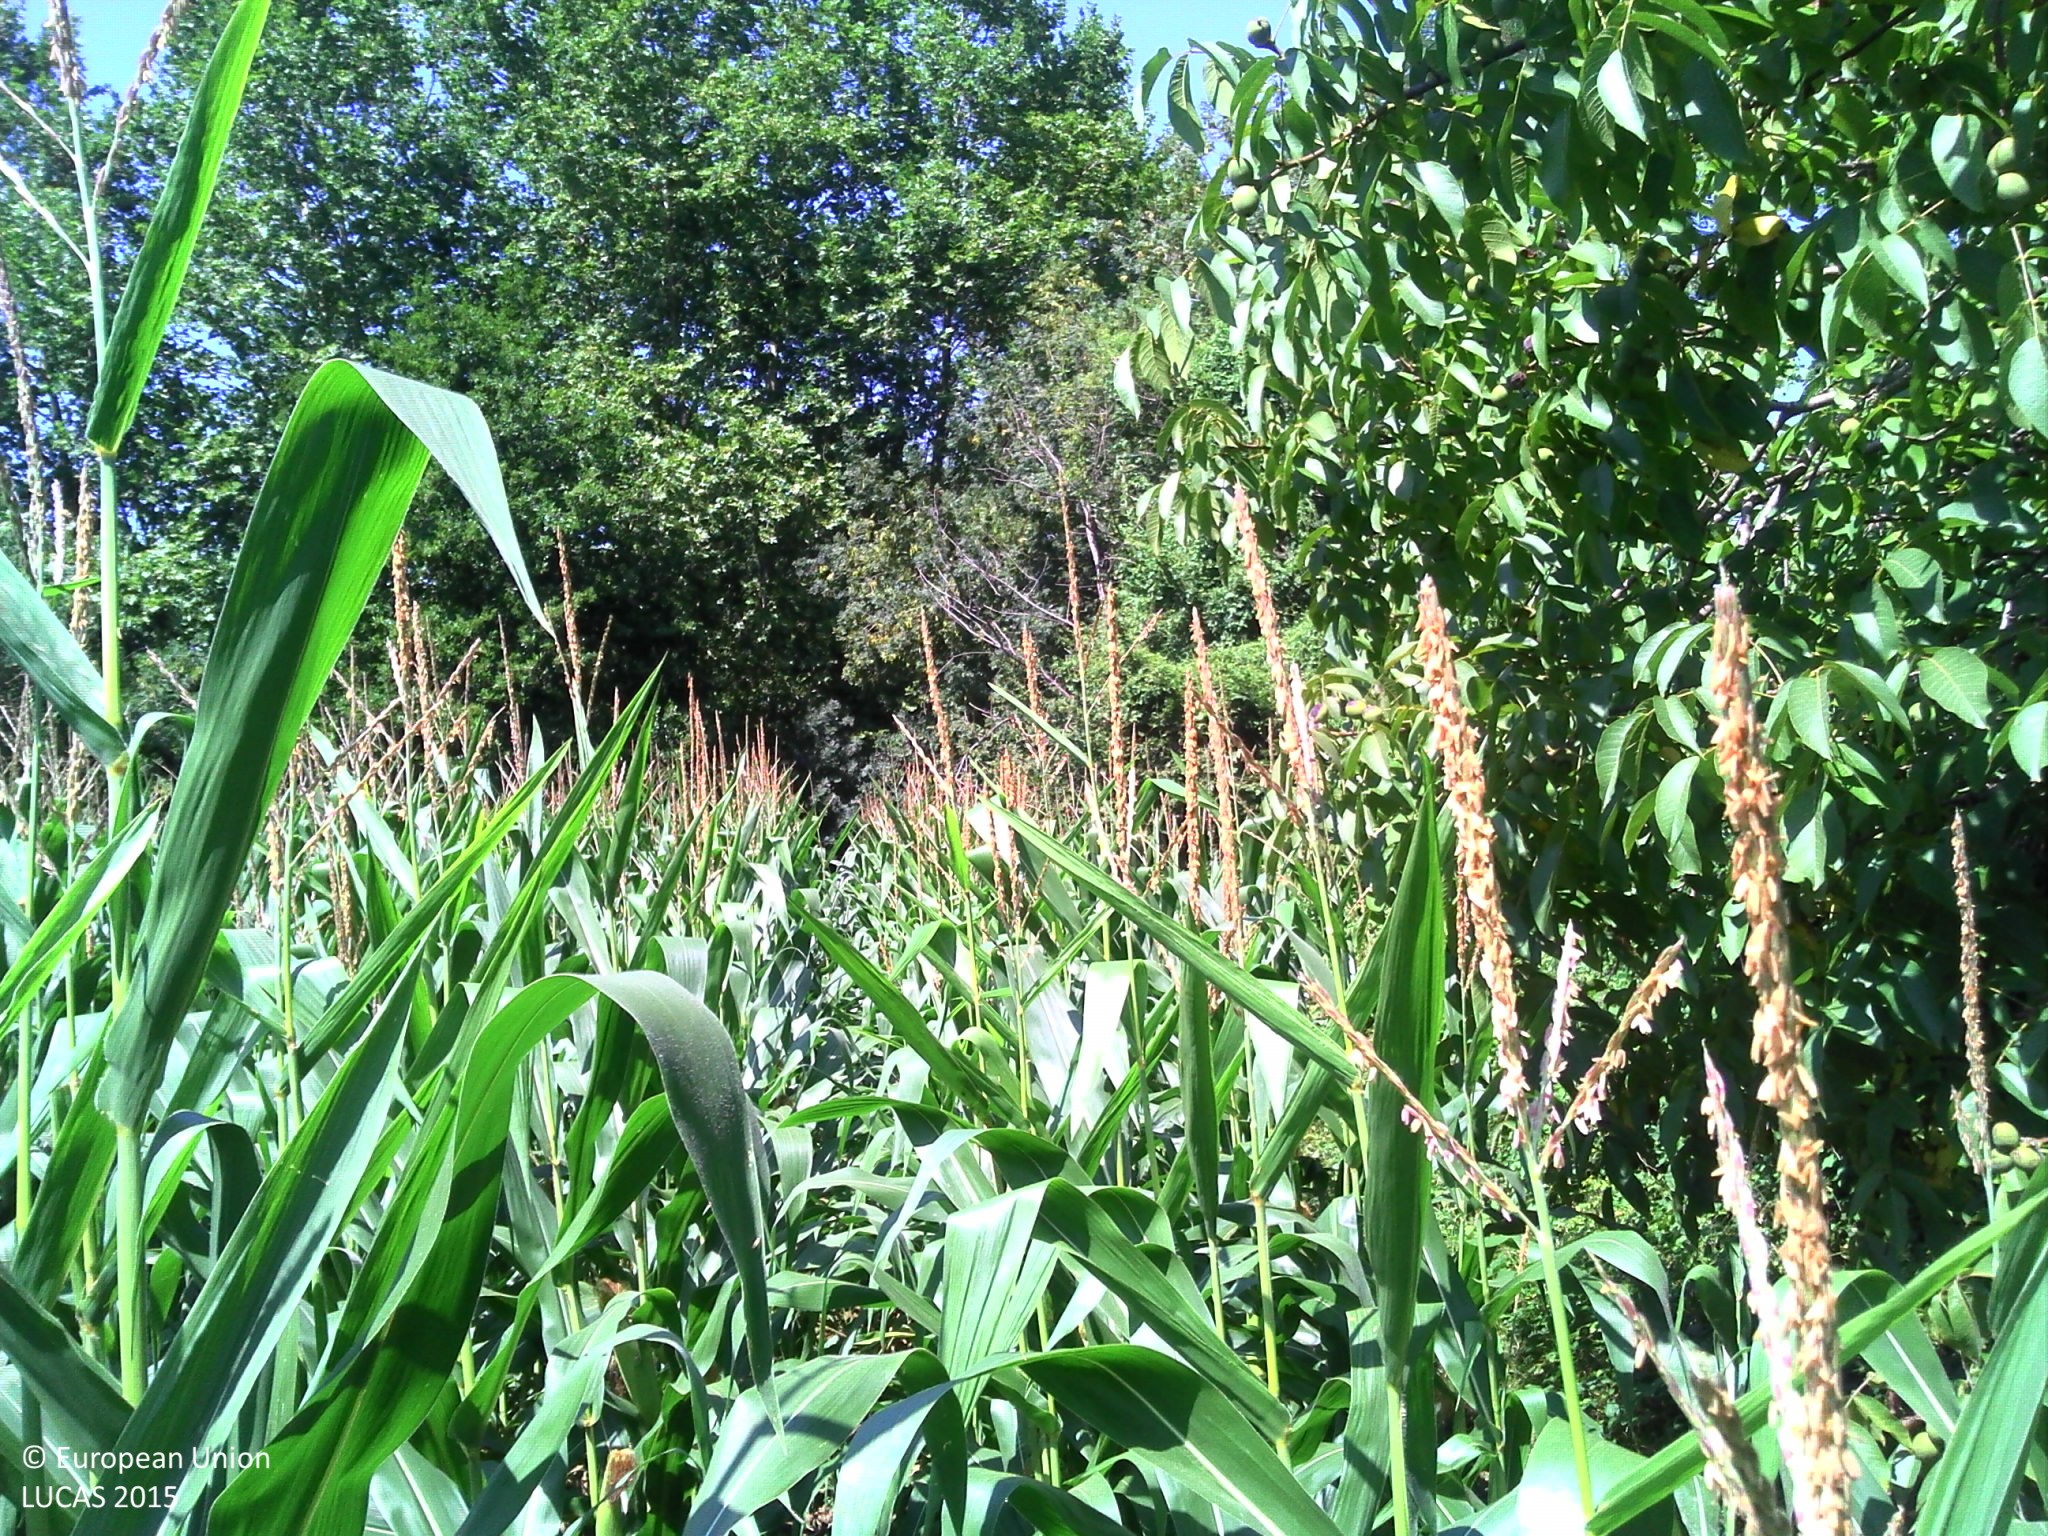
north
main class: Cropland
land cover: Maize
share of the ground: > 75 %
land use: Agriculture (excluding fallow land and kitchen gardens)
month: August
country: FR
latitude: 43.3220
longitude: -1.0493
